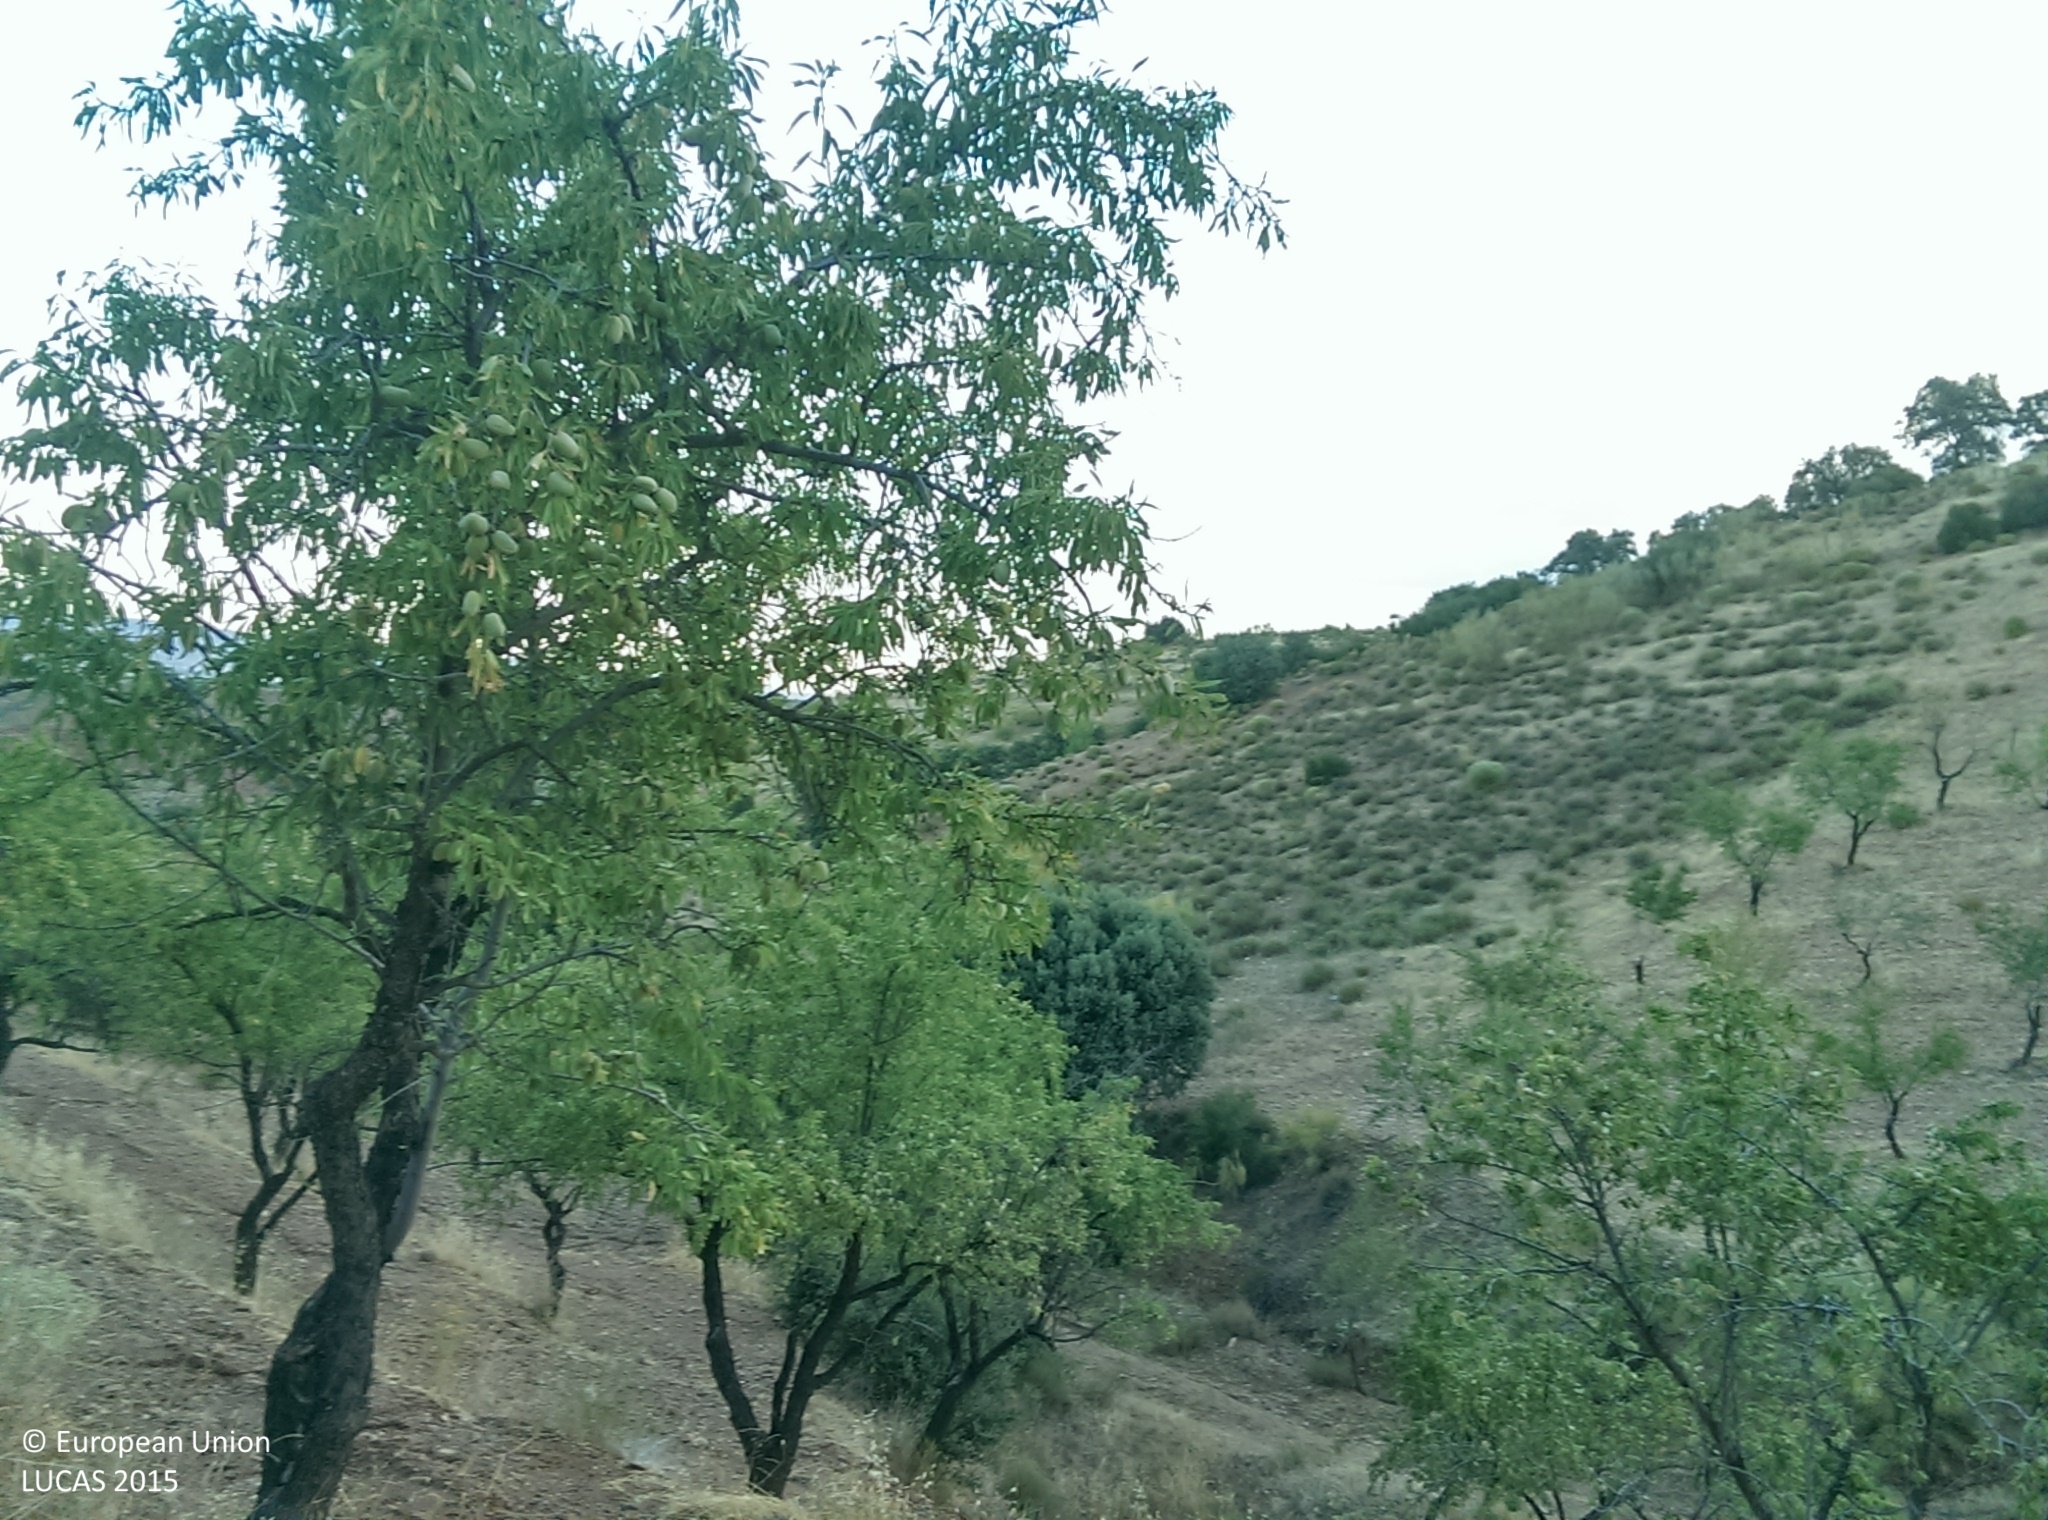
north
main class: Cropland
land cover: Nuts trees
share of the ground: 25 - 50 %
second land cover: Other bare soil
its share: > 75 %
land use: Agriculture (excluding fallow land and kitchen gardens)
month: July
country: ES
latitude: 37.2731
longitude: -3.2613
